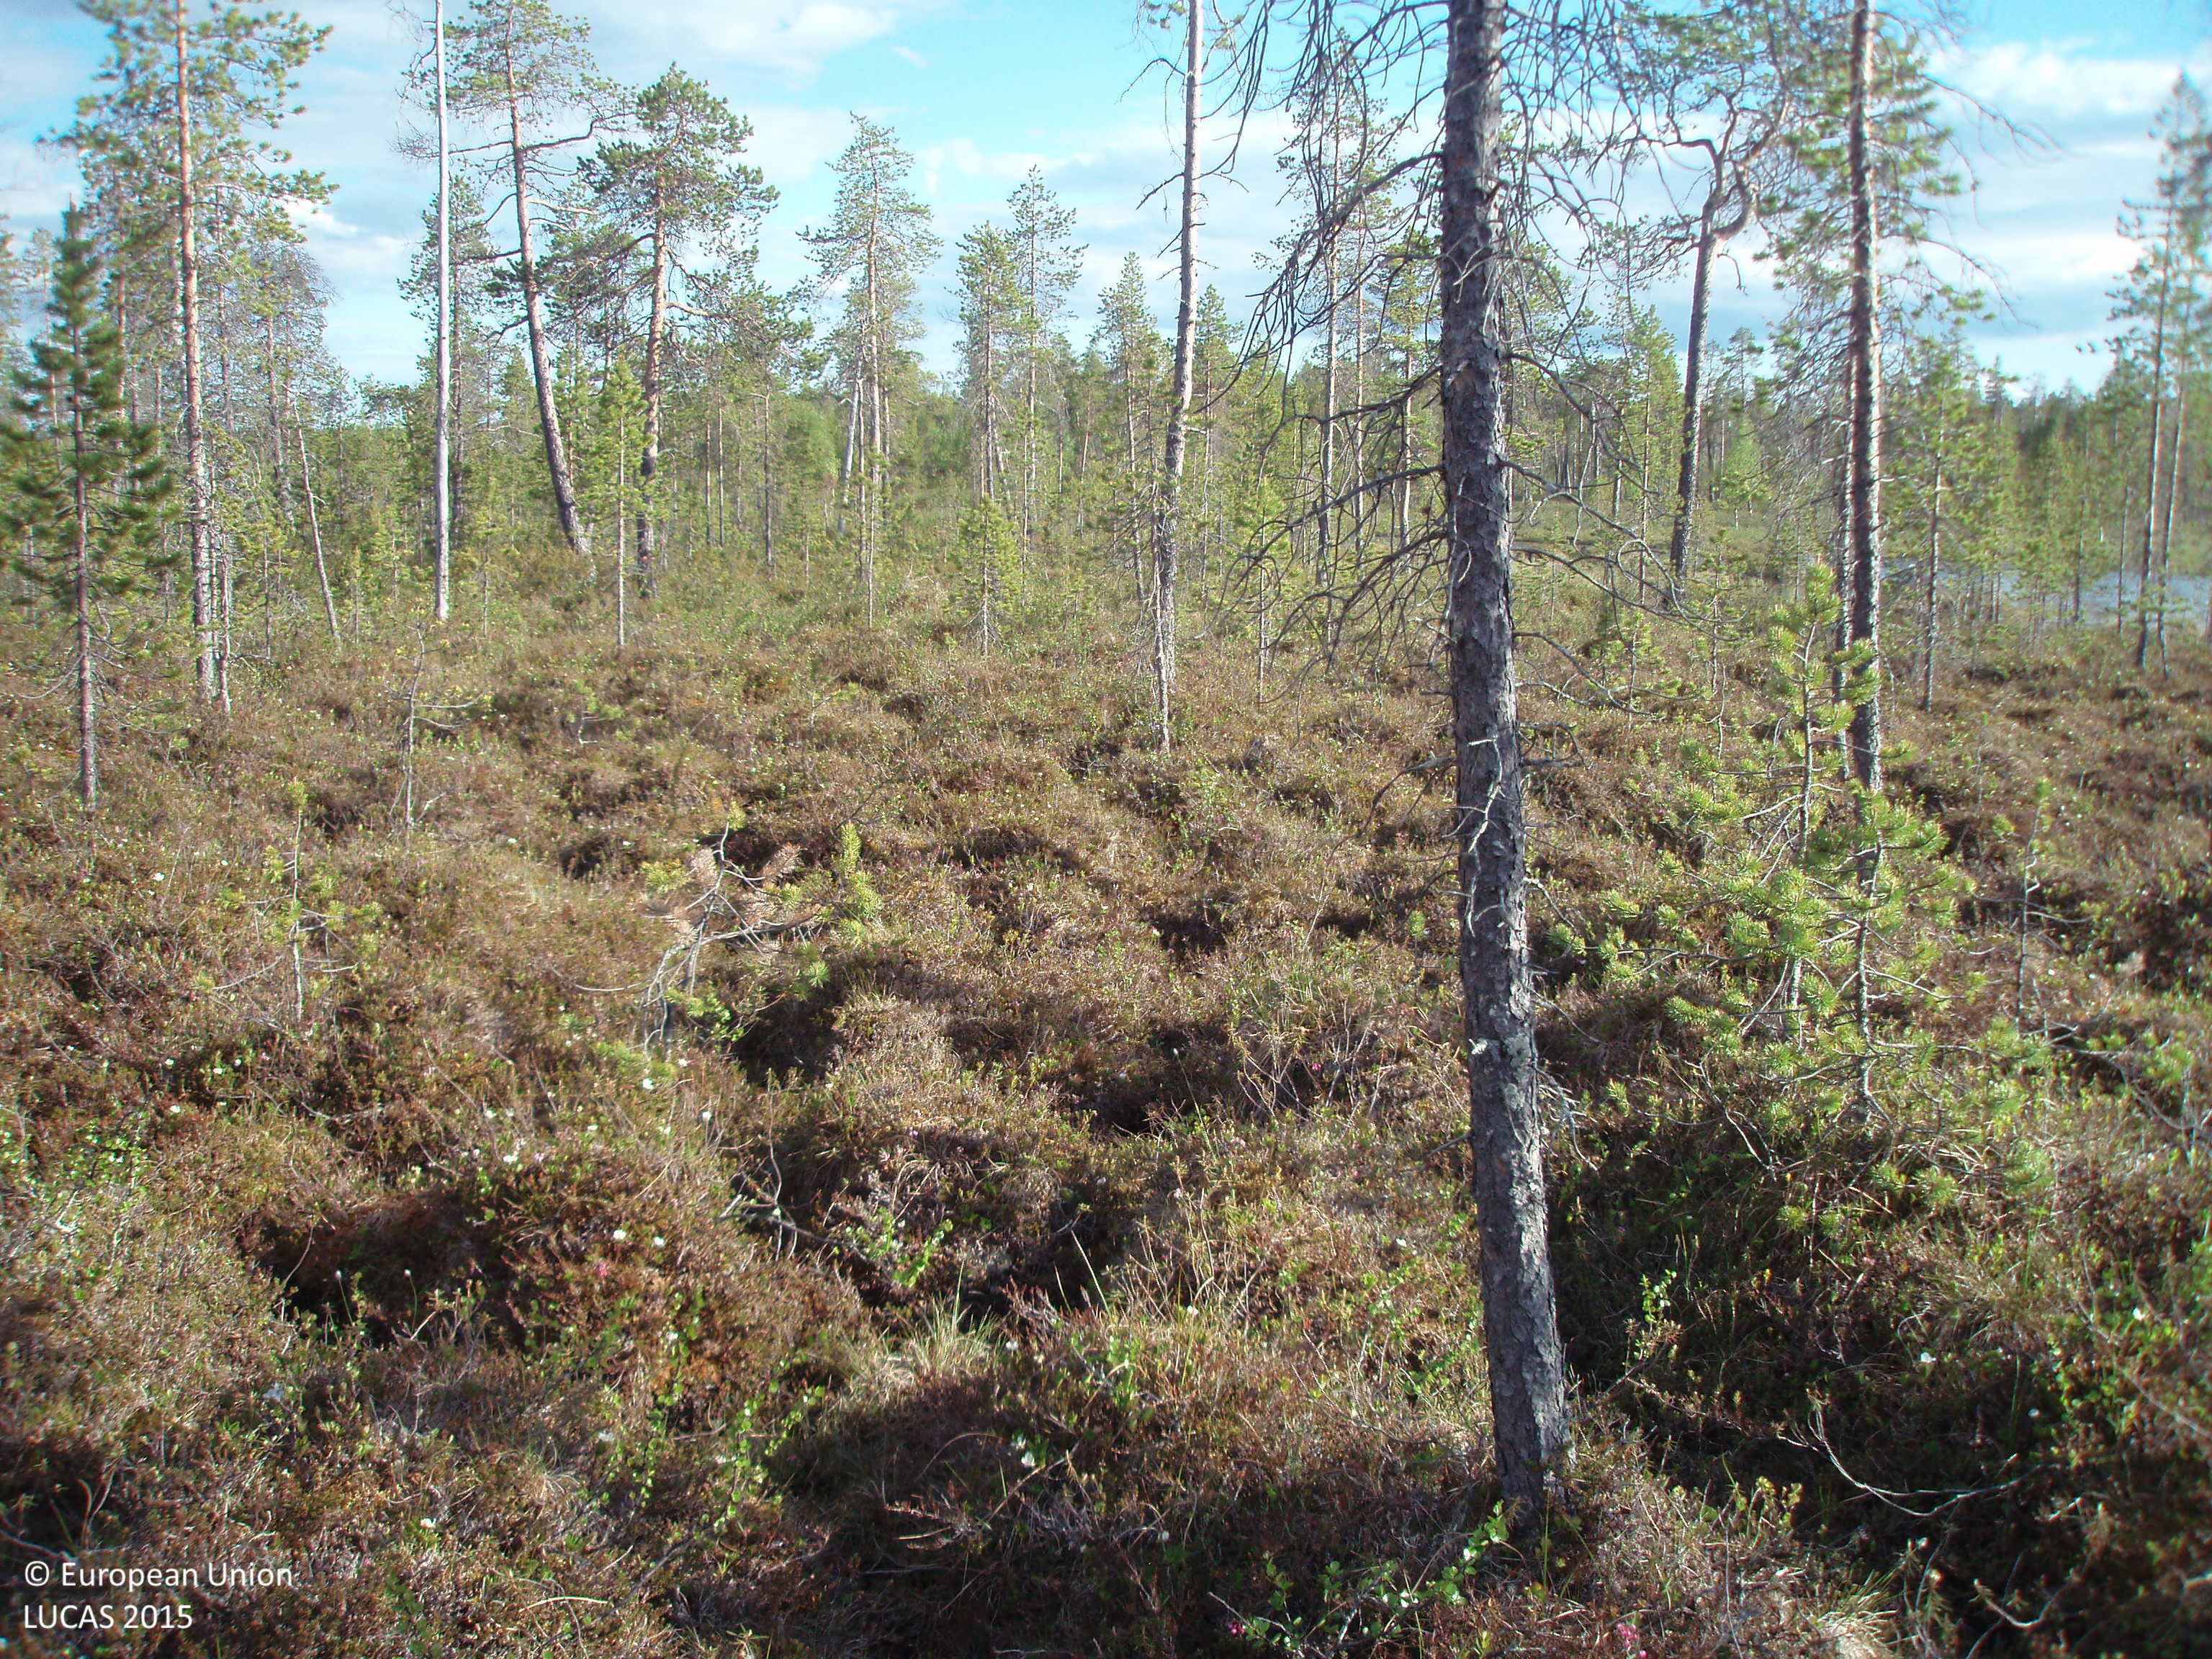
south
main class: Woodland
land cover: Pine dominated coniferous woodland
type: boreal forest
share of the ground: 25 - 50 %
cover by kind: shrubs 60 %, coniferous forest trees 30 %, lichens and mosses 10 %
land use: Semi-natural and natural areas not in use
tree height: > 5 m
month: June
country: FI
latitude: 68.7625
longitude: 28.5350
